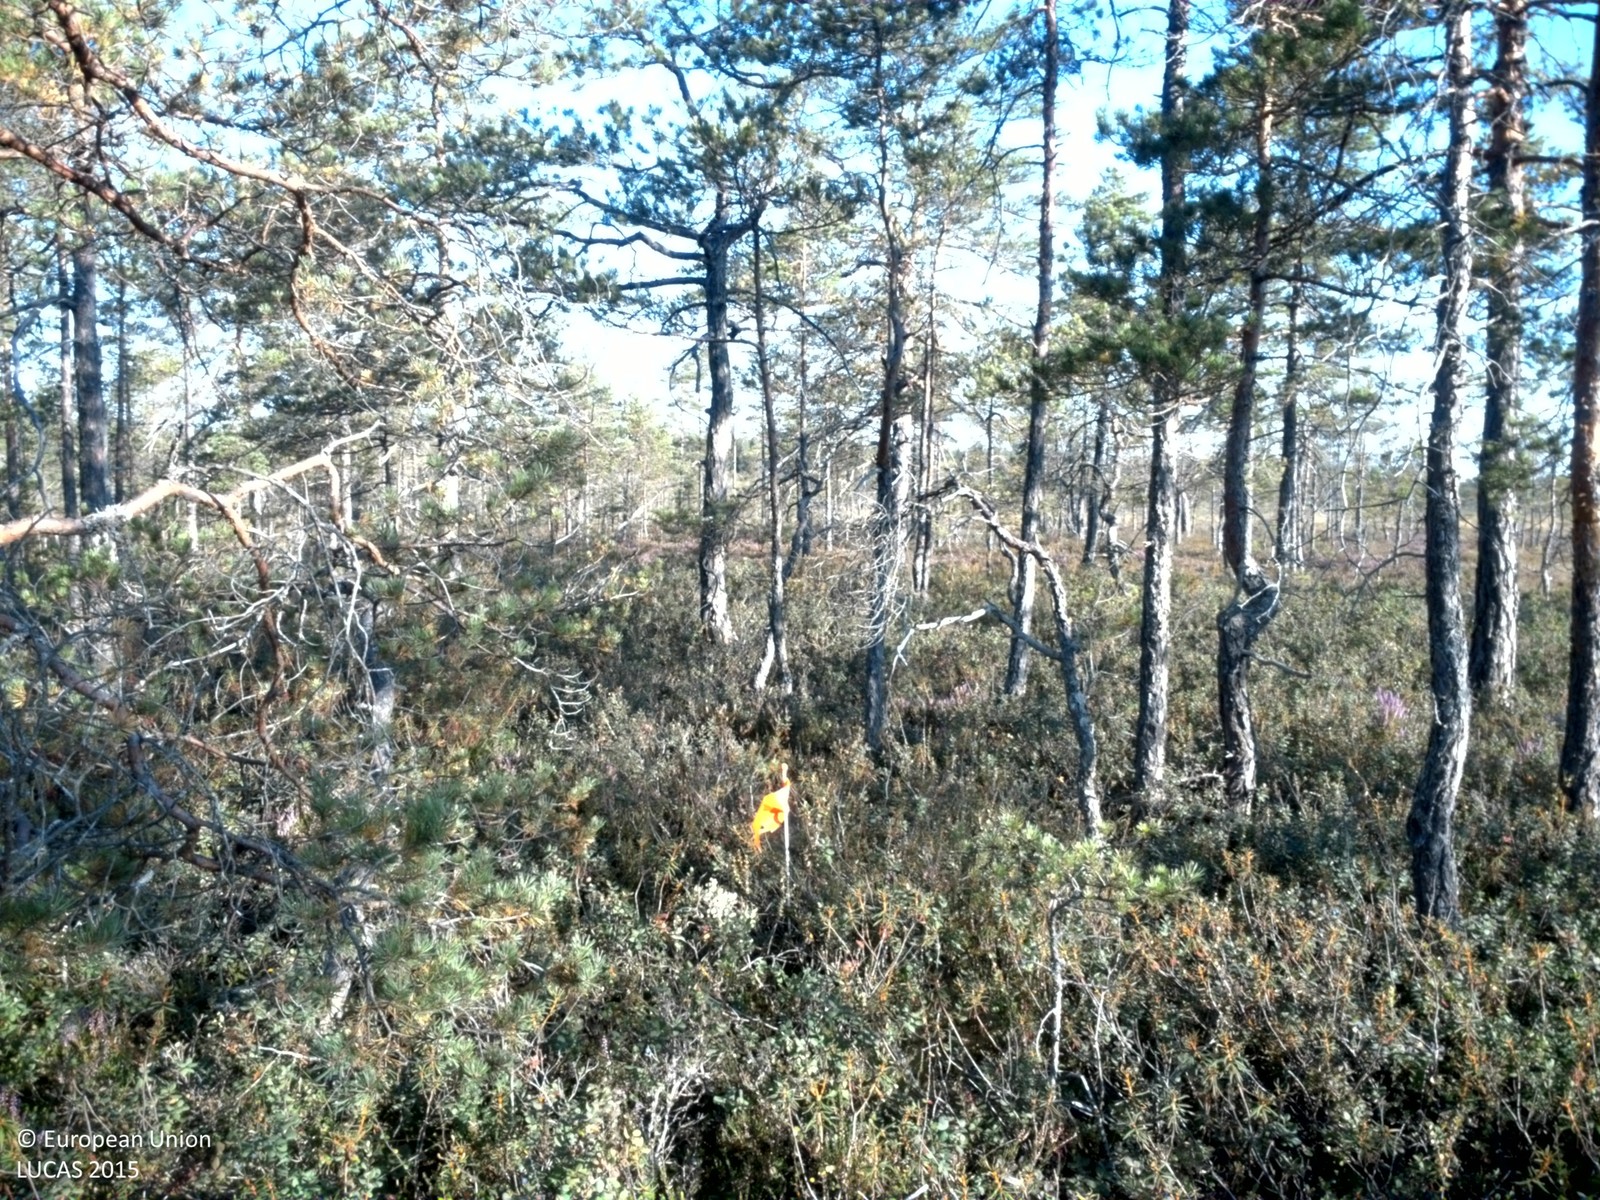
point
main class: Woodland
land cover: Pine dominated coniferous woodland
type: mire and swamp forests
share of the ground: 25 - 50 %
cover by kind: shrubs 50 %, coniferous forest trees 45 %, lichens and mosses 5 %
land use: Semi-natural and natural areas not in use
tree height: < 5 m
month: August
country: SE
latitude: 59.7645
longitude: 15.9906
